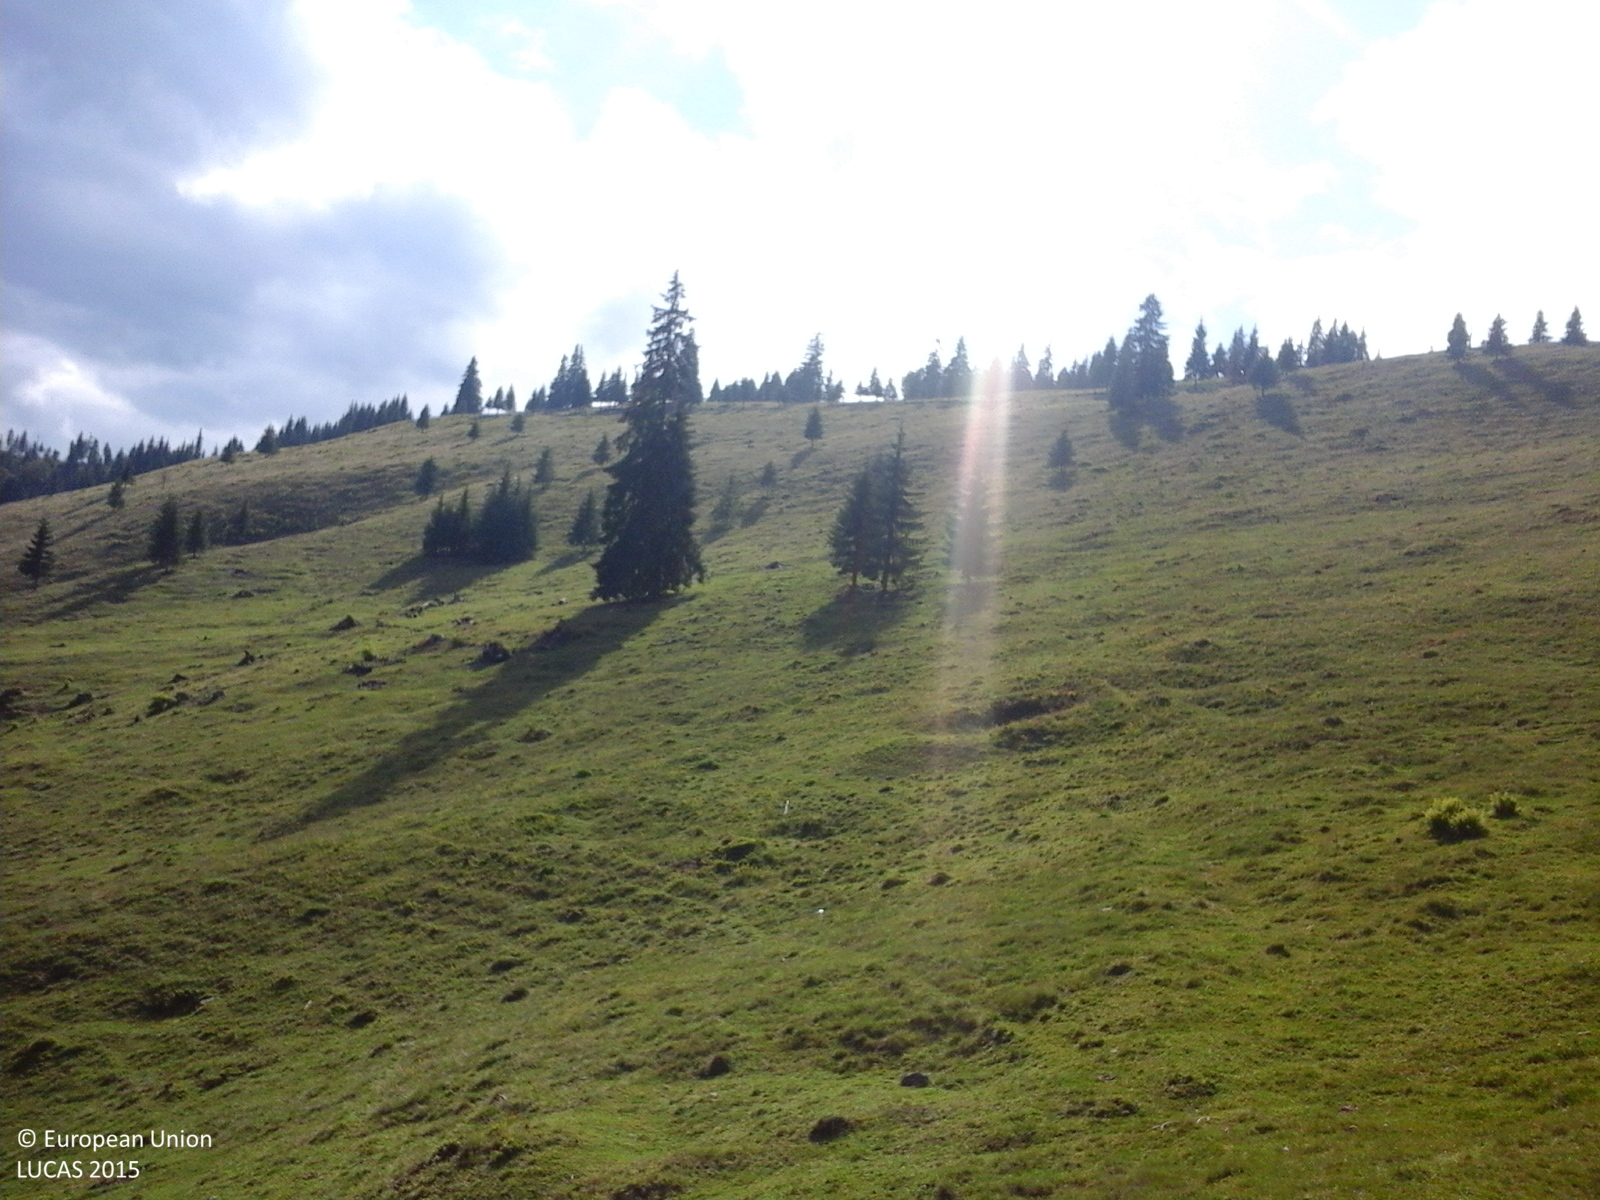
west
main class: Grassland
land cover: Grassland without tree/shrub cover
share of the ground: > 75 %
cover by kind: herbaceous plants 100 %
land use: Agriculture (excluding fallow land and kitchen gardens)
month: June
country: RO
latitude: 47.4901
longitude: 25.3359
